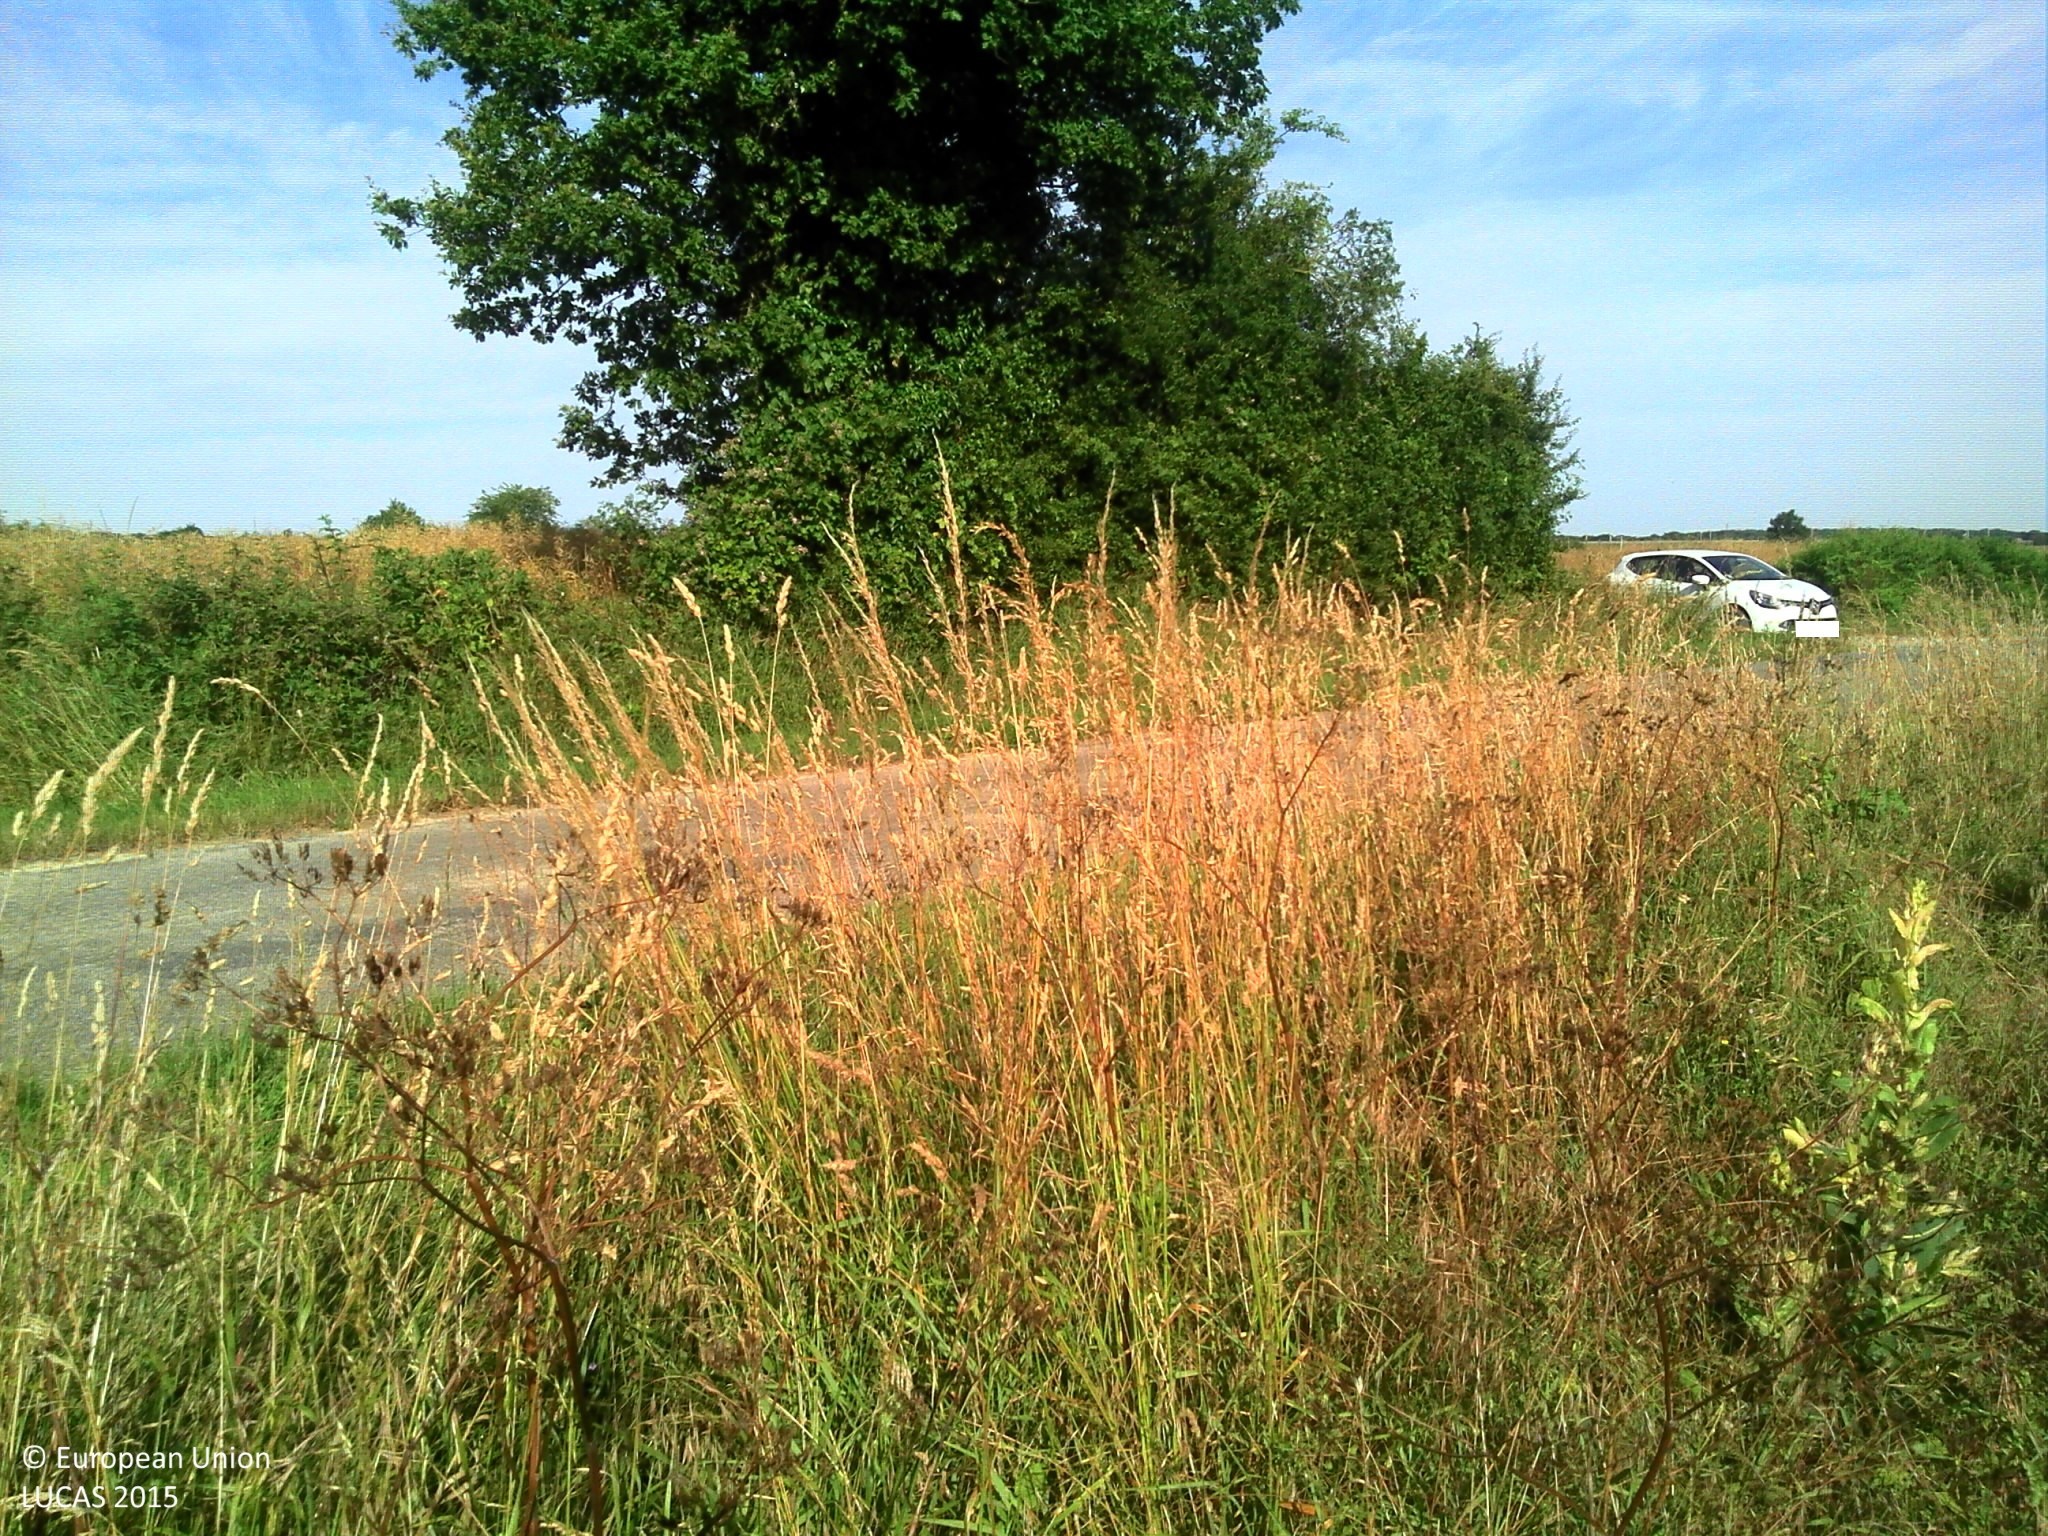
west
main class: Cropland
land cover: Maize
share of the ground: > 75 %
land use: Agriculture (excluding fallow land and kitchen gardens)
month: June
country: FR
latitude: 46.5029
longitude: 0.2463
